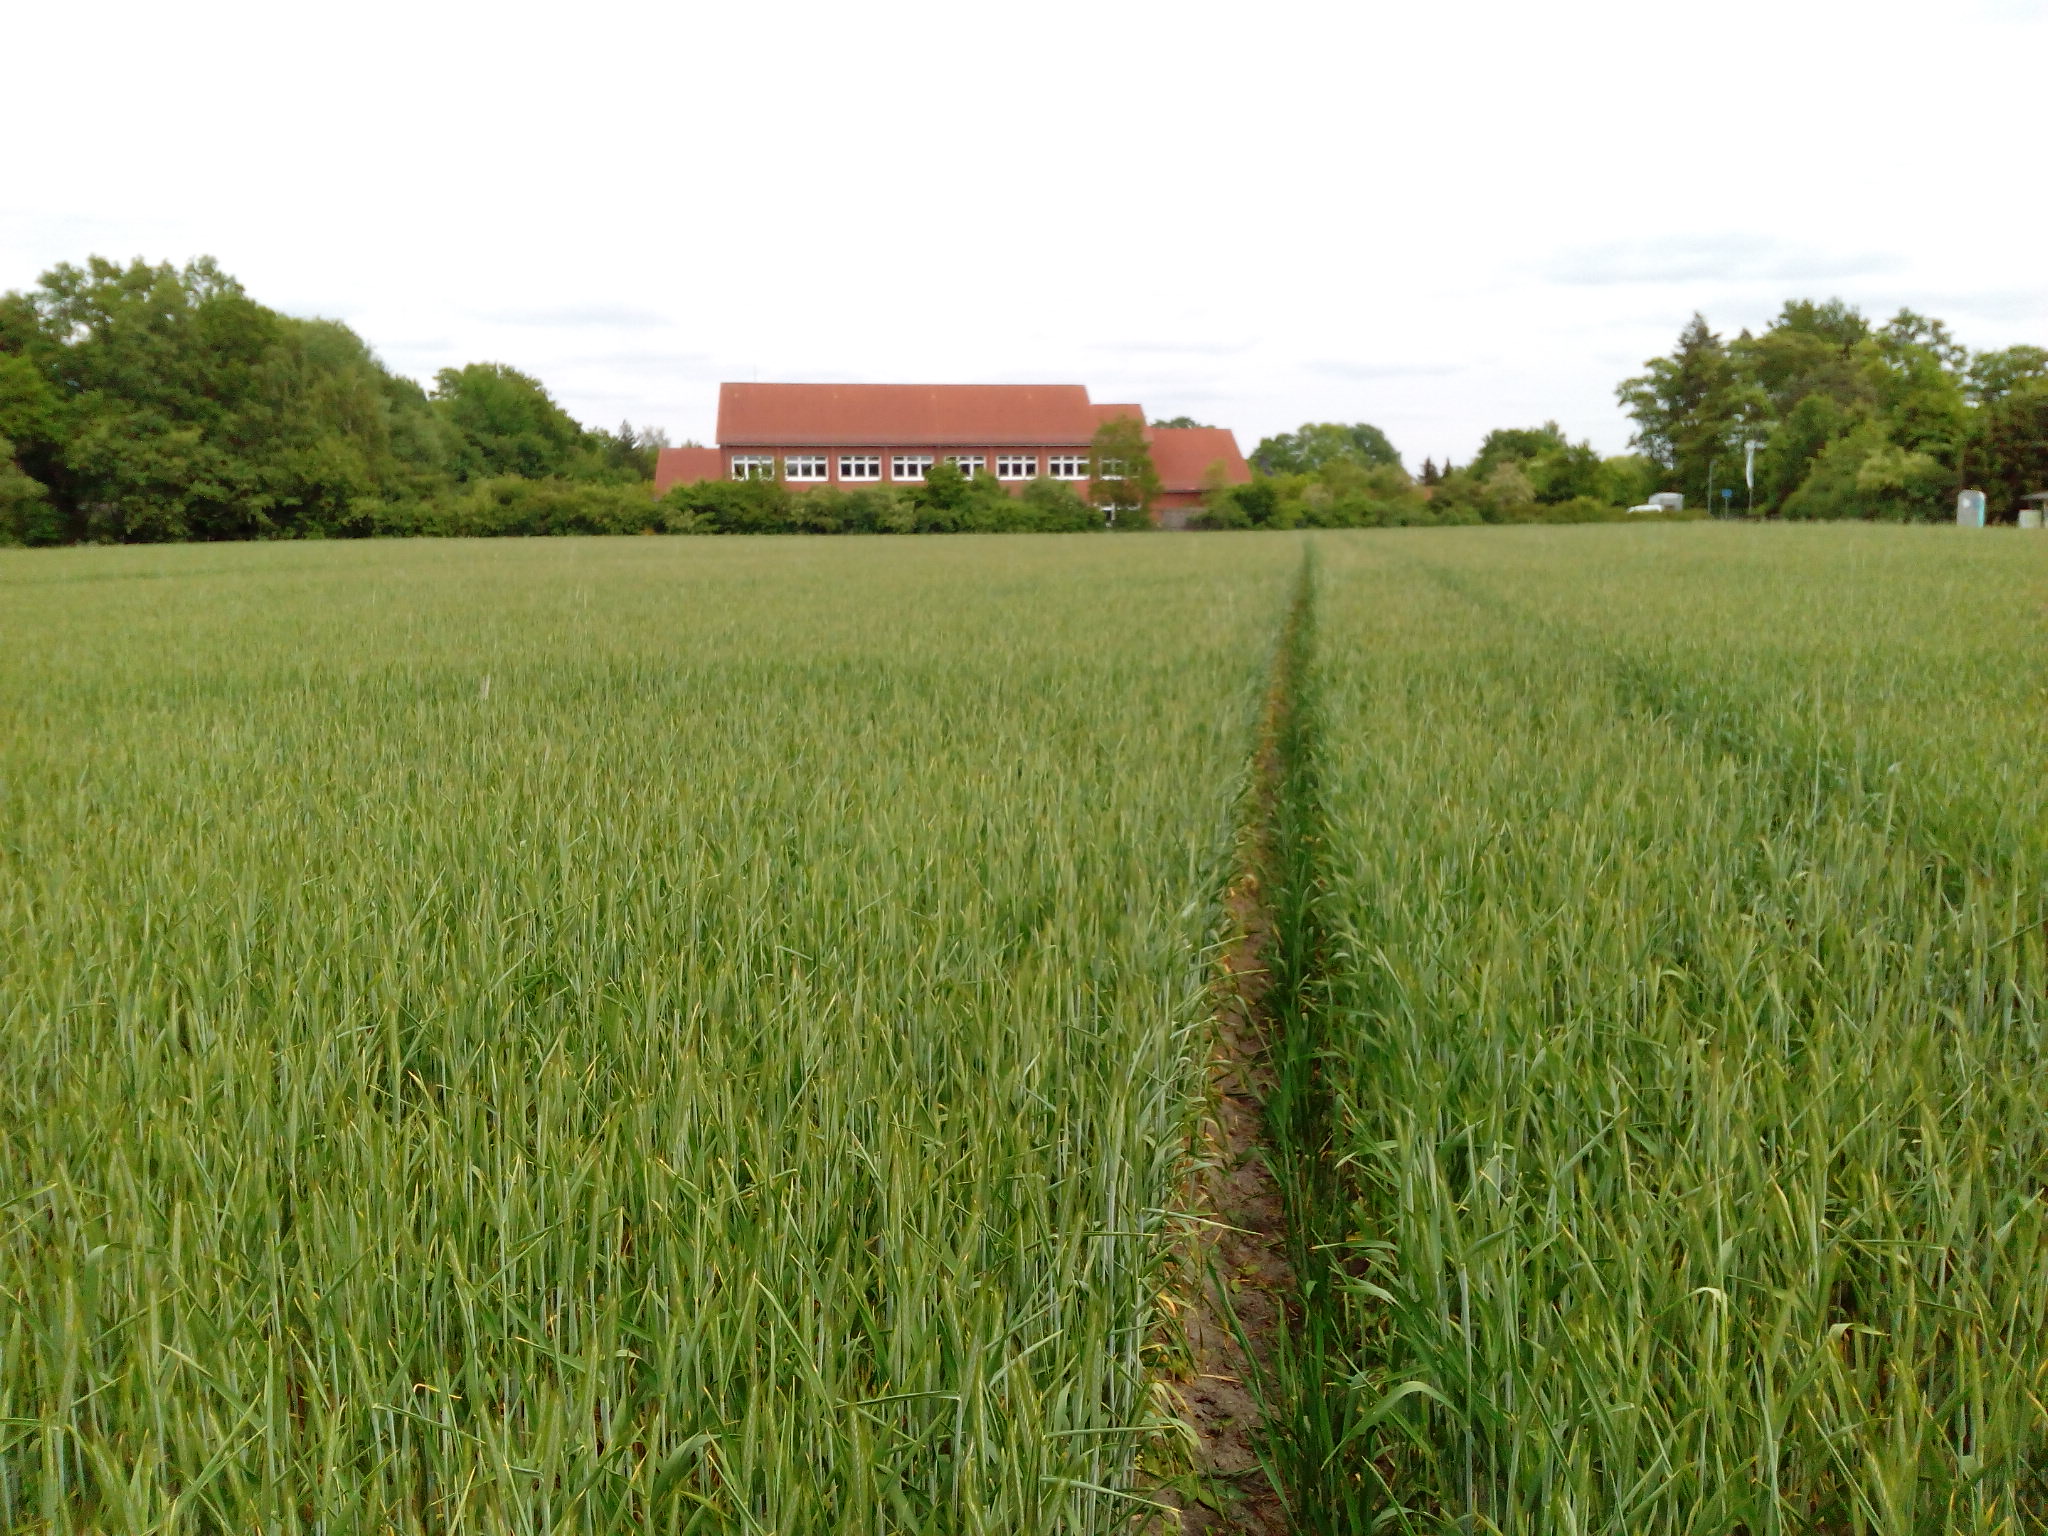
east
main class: Cropland
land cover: Rye
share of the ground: > 75 %
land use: Agriculture (excluding fallow land and kitchen gardens)
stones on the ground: < 10 %
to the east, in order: Rye; Broadleaved woodland; Artificial constructions in urban areas
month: June
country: DE
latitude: 52.6830
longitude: 9.8965
